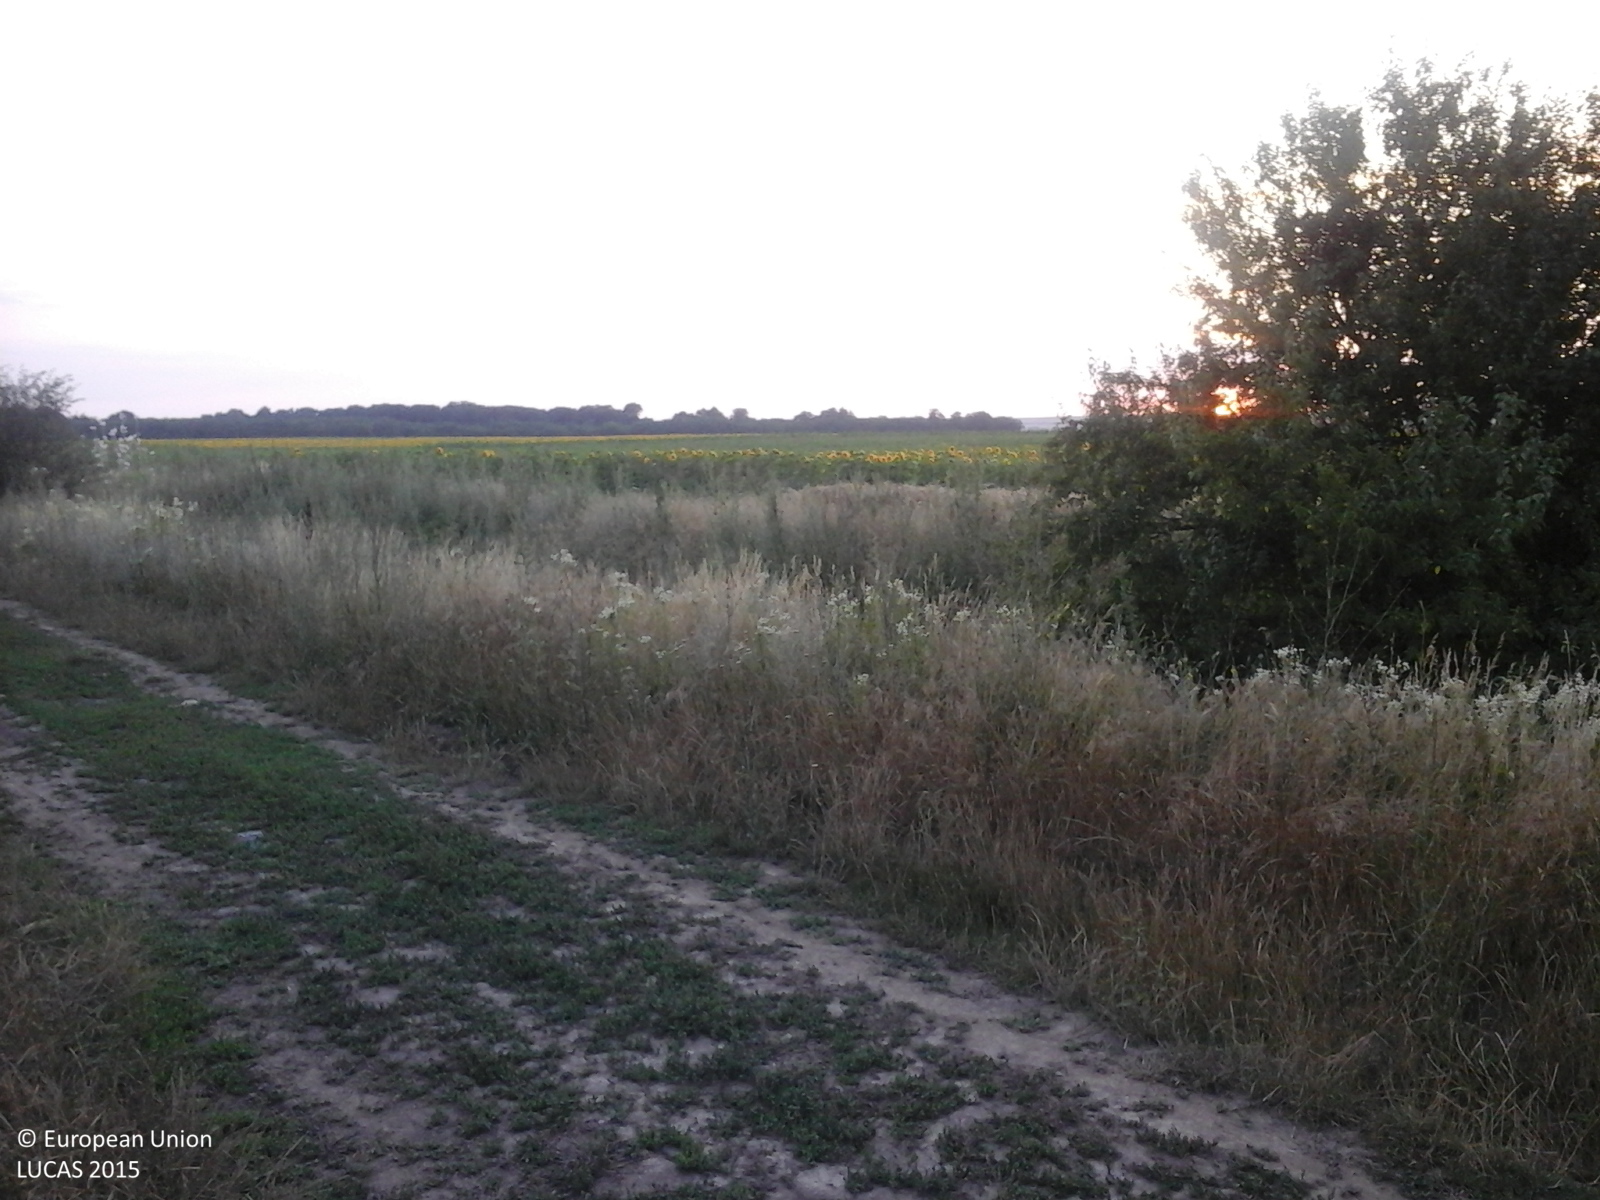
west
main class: Cropland
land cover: Sunflower
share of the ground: > 75 %
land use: Agriculture (excluding fallow land and kitchen gardens)
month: July
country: RO
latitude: 43.9327
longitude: 25.9539
